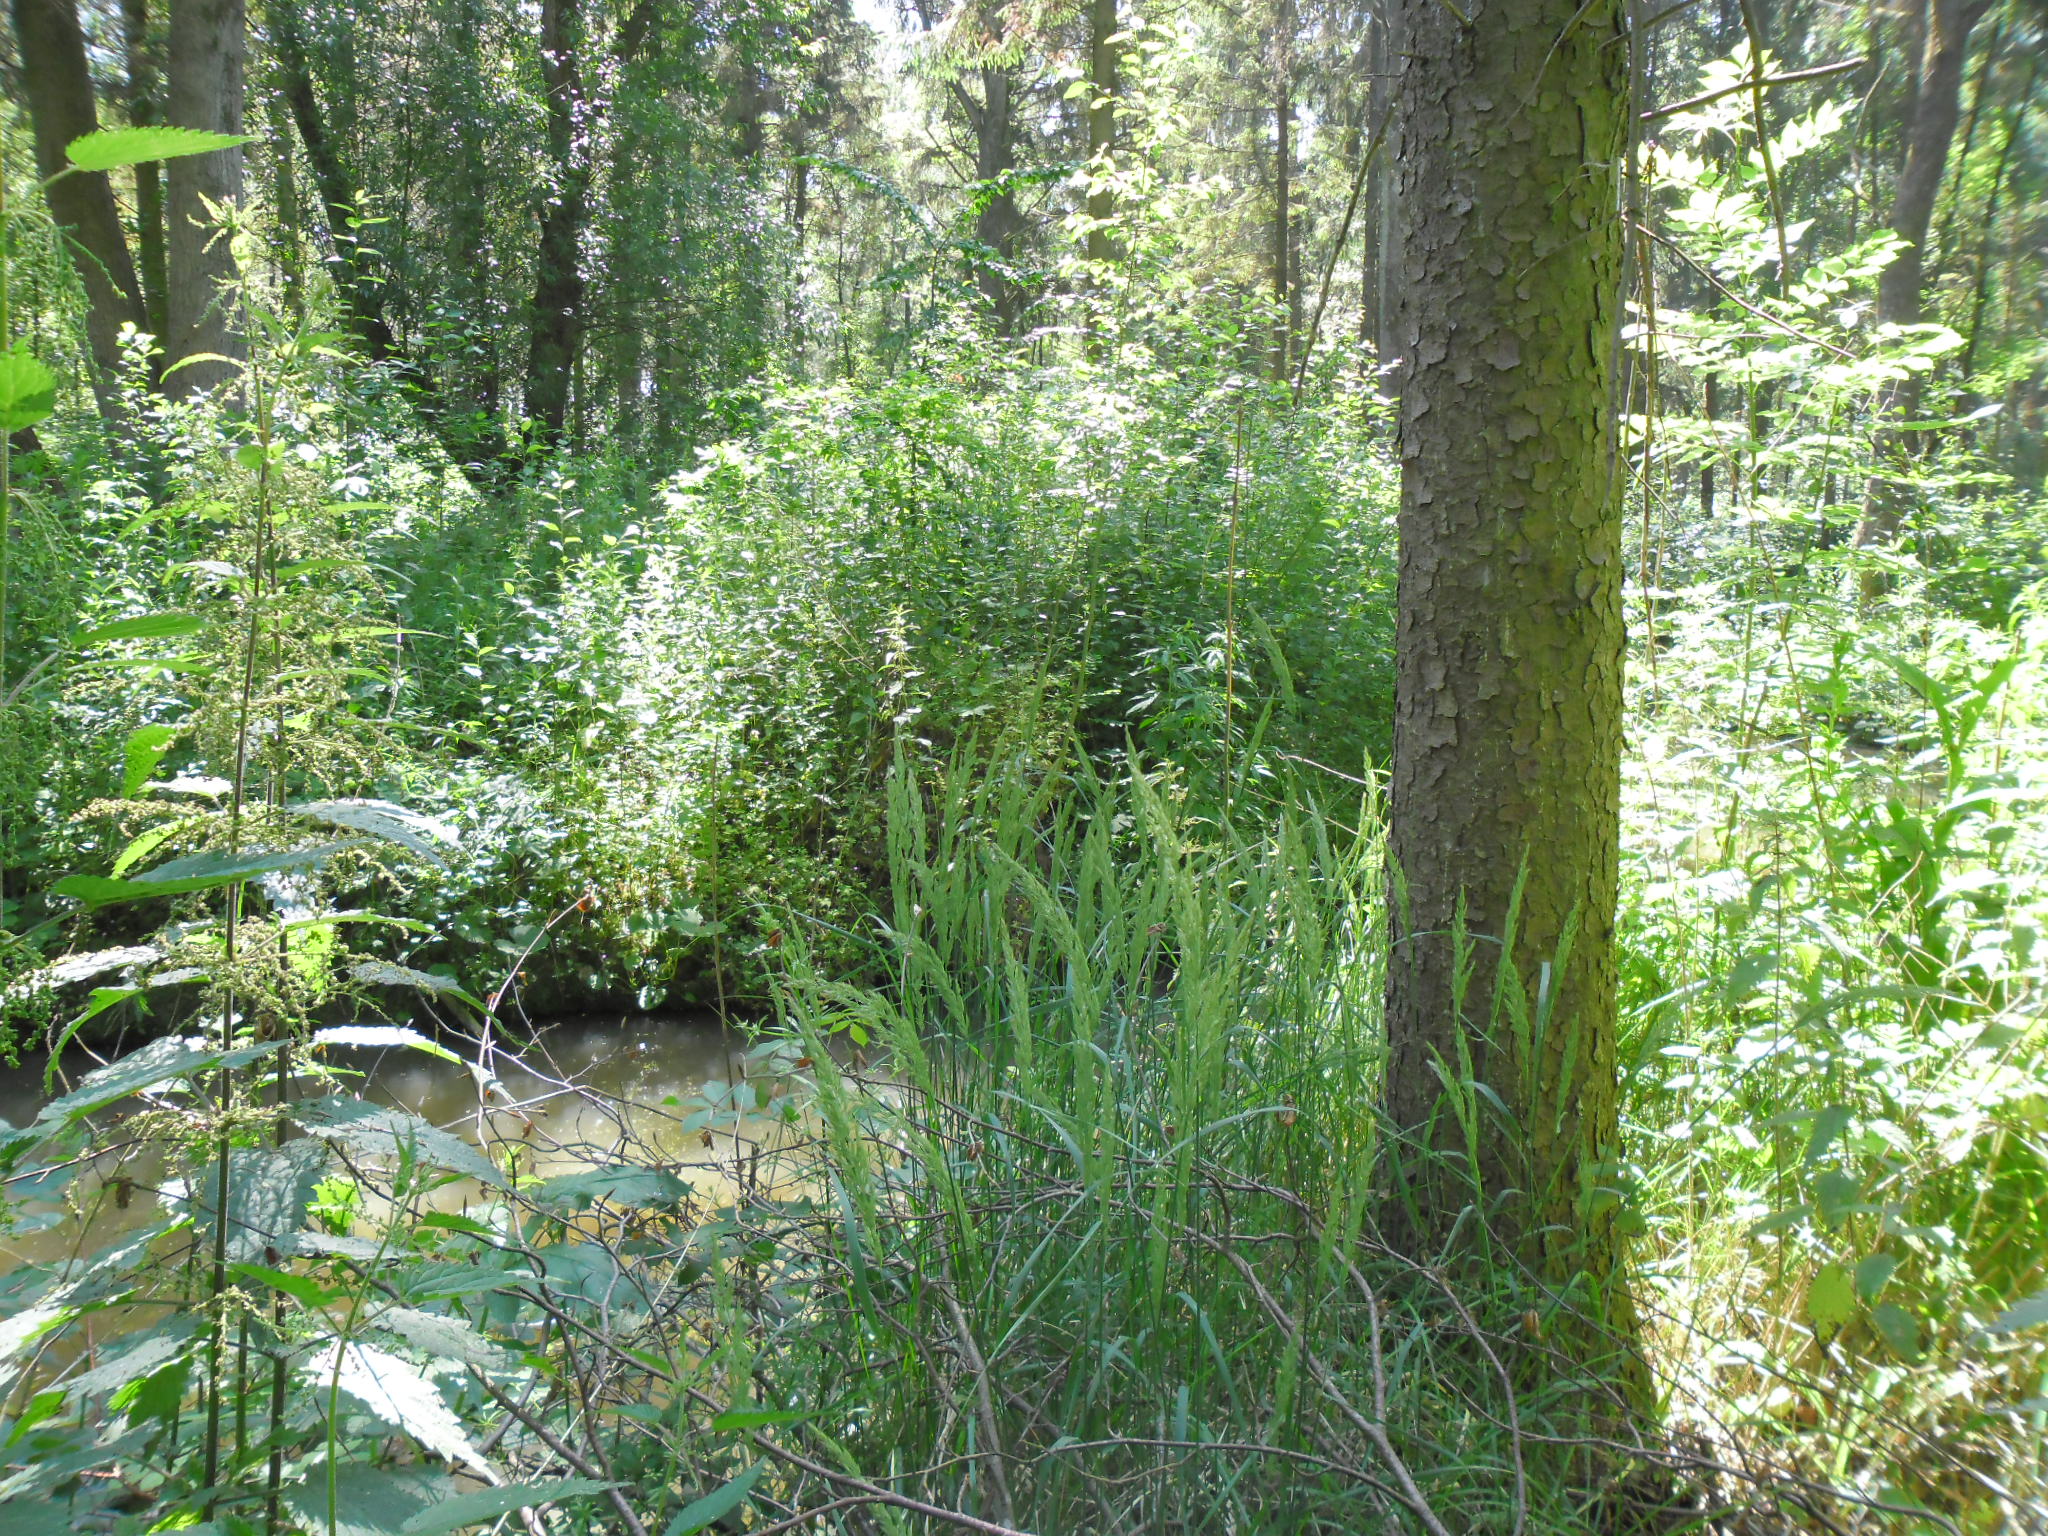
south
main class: Woodland
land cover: Broadleaved woodland
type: mesophytic deciduous forest
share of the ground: > 75 %
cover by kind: broadleaved forest trees 100 %
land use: Amenities, museums, leisure
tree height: > 5 m
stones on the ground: < 10 %
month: June
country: NL
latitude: 52.5432
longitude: 5.4716
